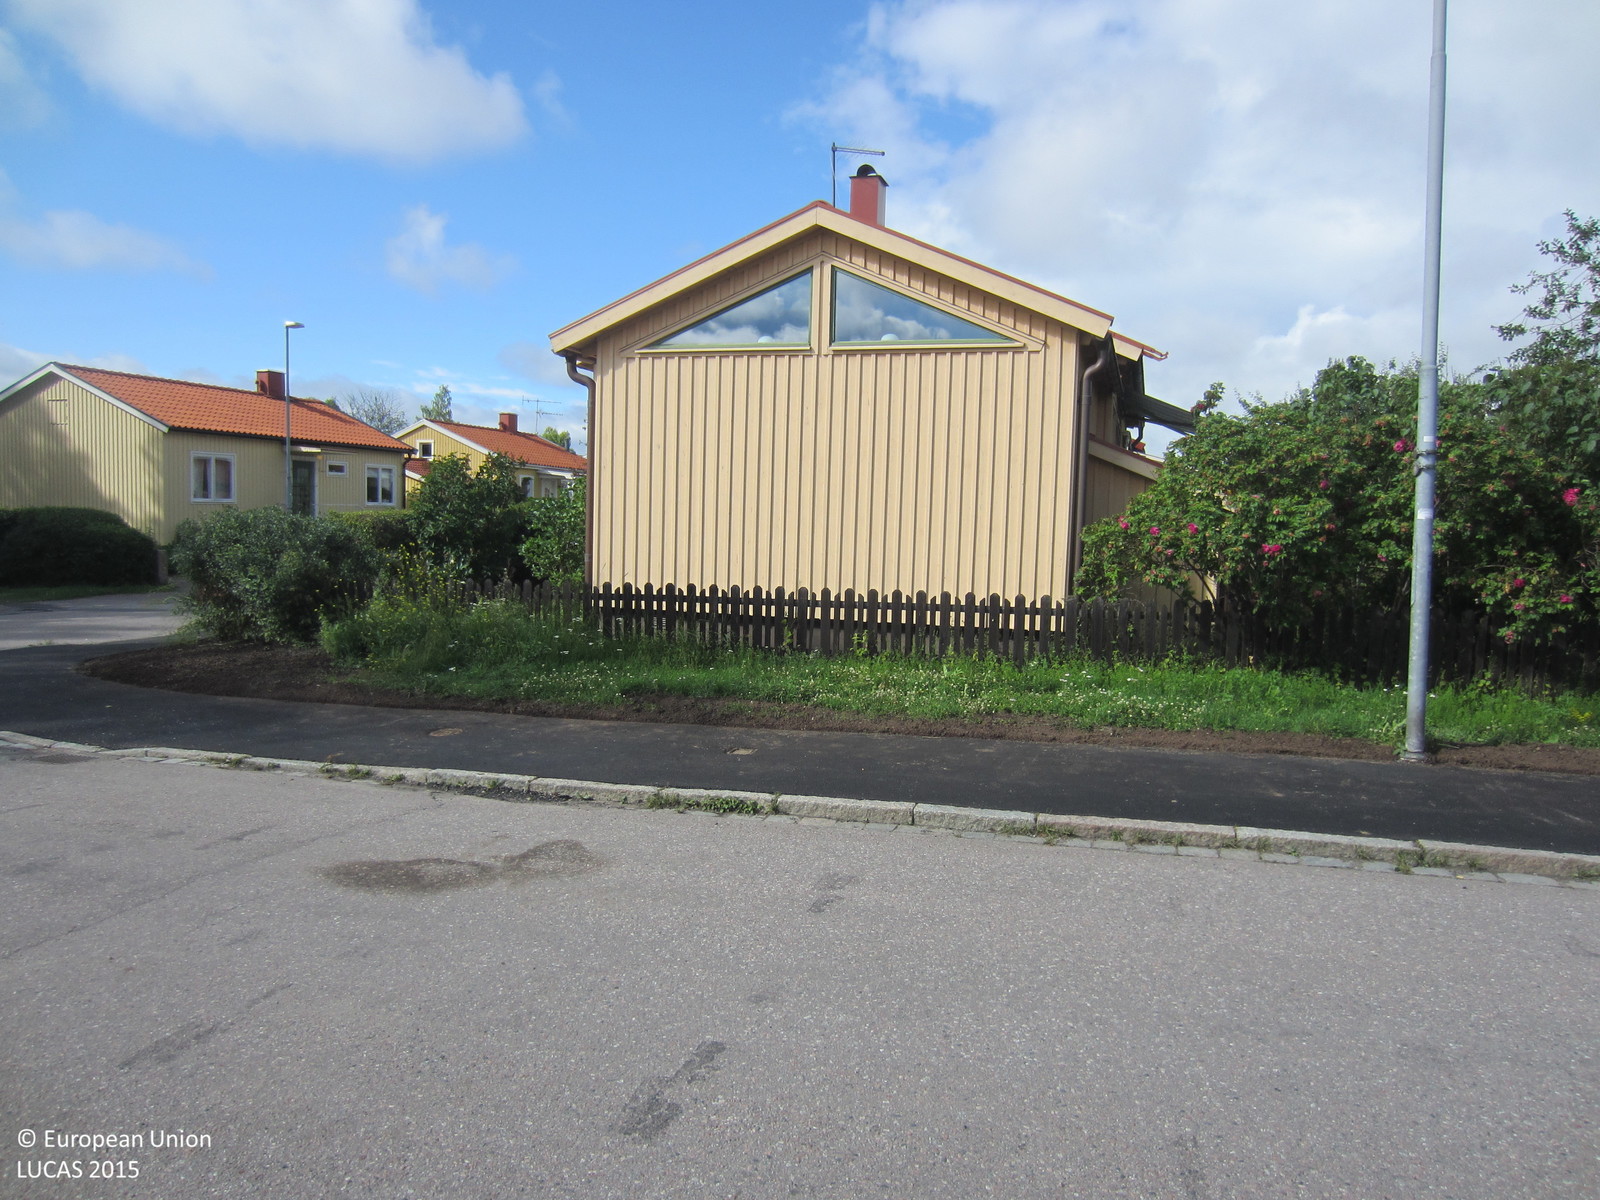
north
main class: Cropland
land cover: Apple fruit
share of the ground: > 75 %
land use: Kitchen garden
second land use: Amenities, museums, leisure
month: July
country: SE
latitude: 59.8481
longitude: 17.6156
